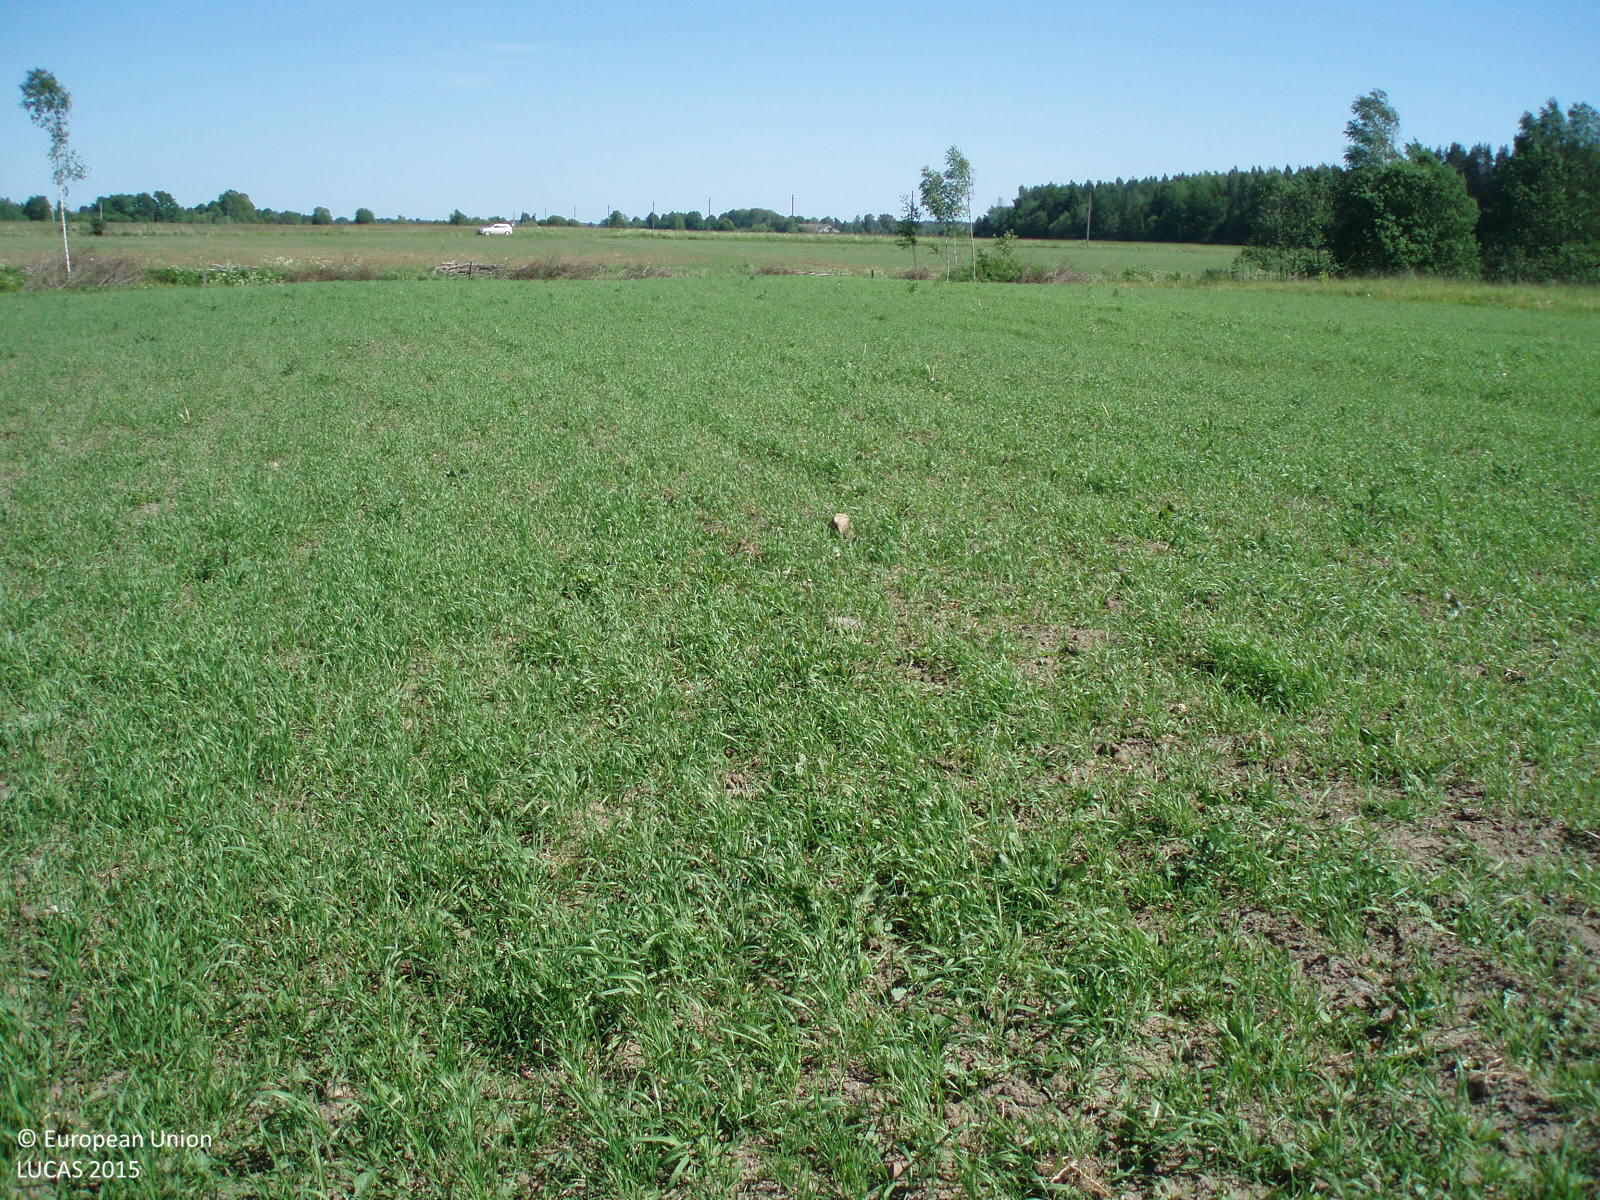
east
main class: Cropland
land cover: Rye
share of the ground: > 75 %
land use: Agriculture (excluding fallow land and kitchen gardens)
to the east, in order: Rye; Grassland with sparse tree/shrub cover; Rivers and streams; Grassland with sparse tree/shrub cover; Grassland without tree/shrub cover; Barley; Grass margins; Paved roads, cycling and walking lanes; Grassland without tree/shrub cover
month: June
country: LT
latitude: 56.2206
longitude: 22.5904
